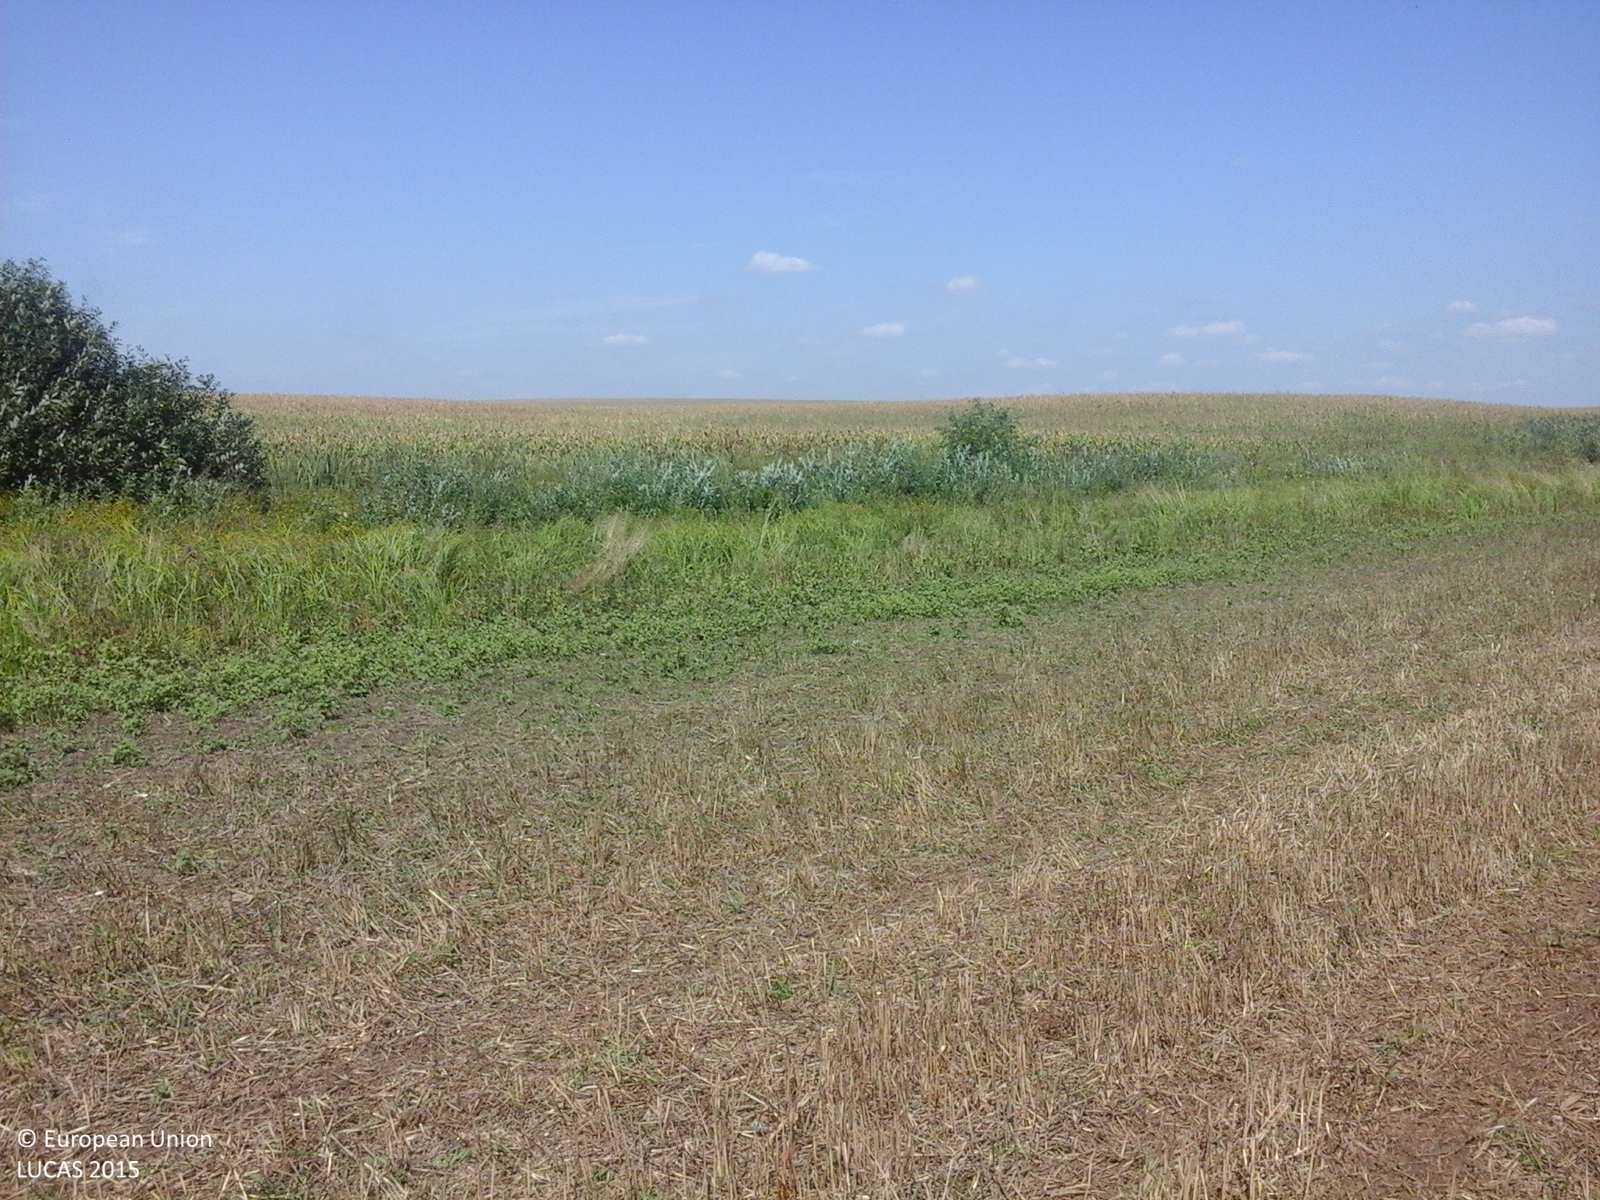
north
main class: Cropland
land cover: Common wheat
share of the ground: 50 - 75 %
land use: Agriculture (excluding fallow land and kitchen gardens)
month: August
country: RO
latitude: 45.9671
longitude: 21.1418
